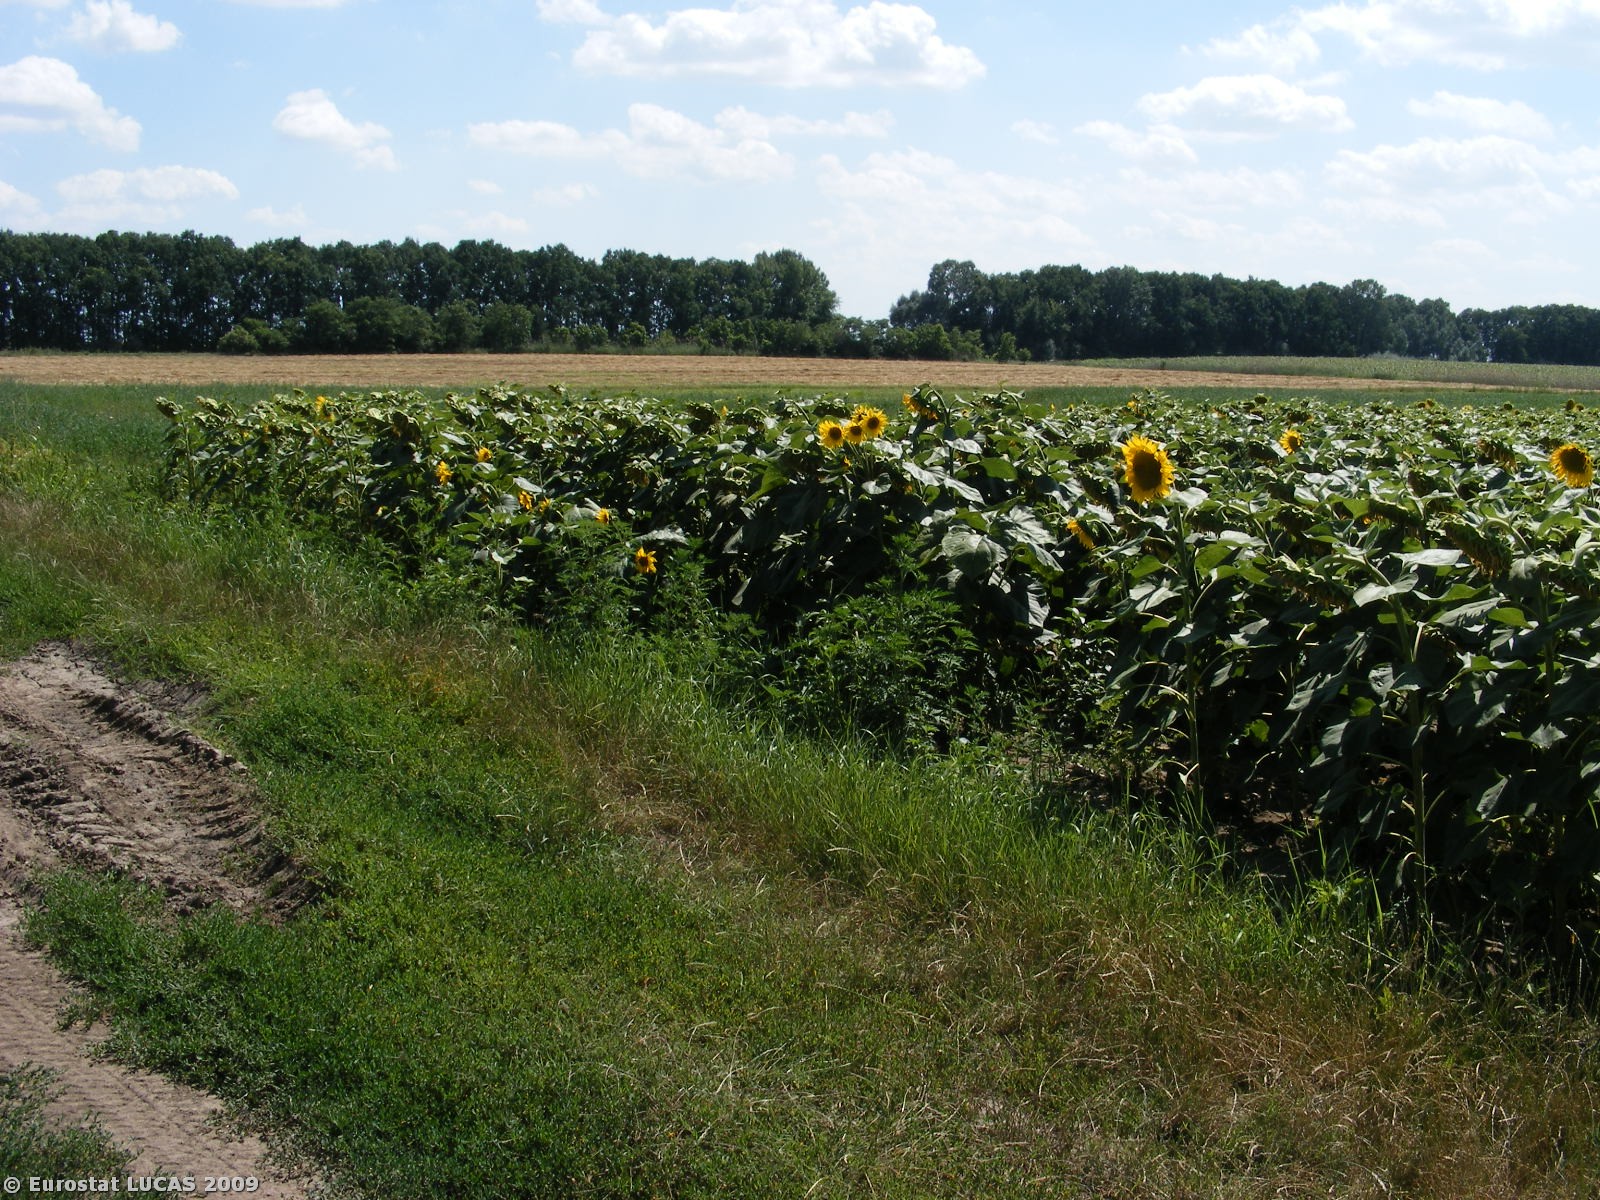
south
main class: Cropland
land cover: Sunflower
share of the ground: > 75 %
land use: Agriculture (excluding fallow land and kitchen gardens)
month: July
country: HU
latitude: 47.3018
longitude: 21.7498
